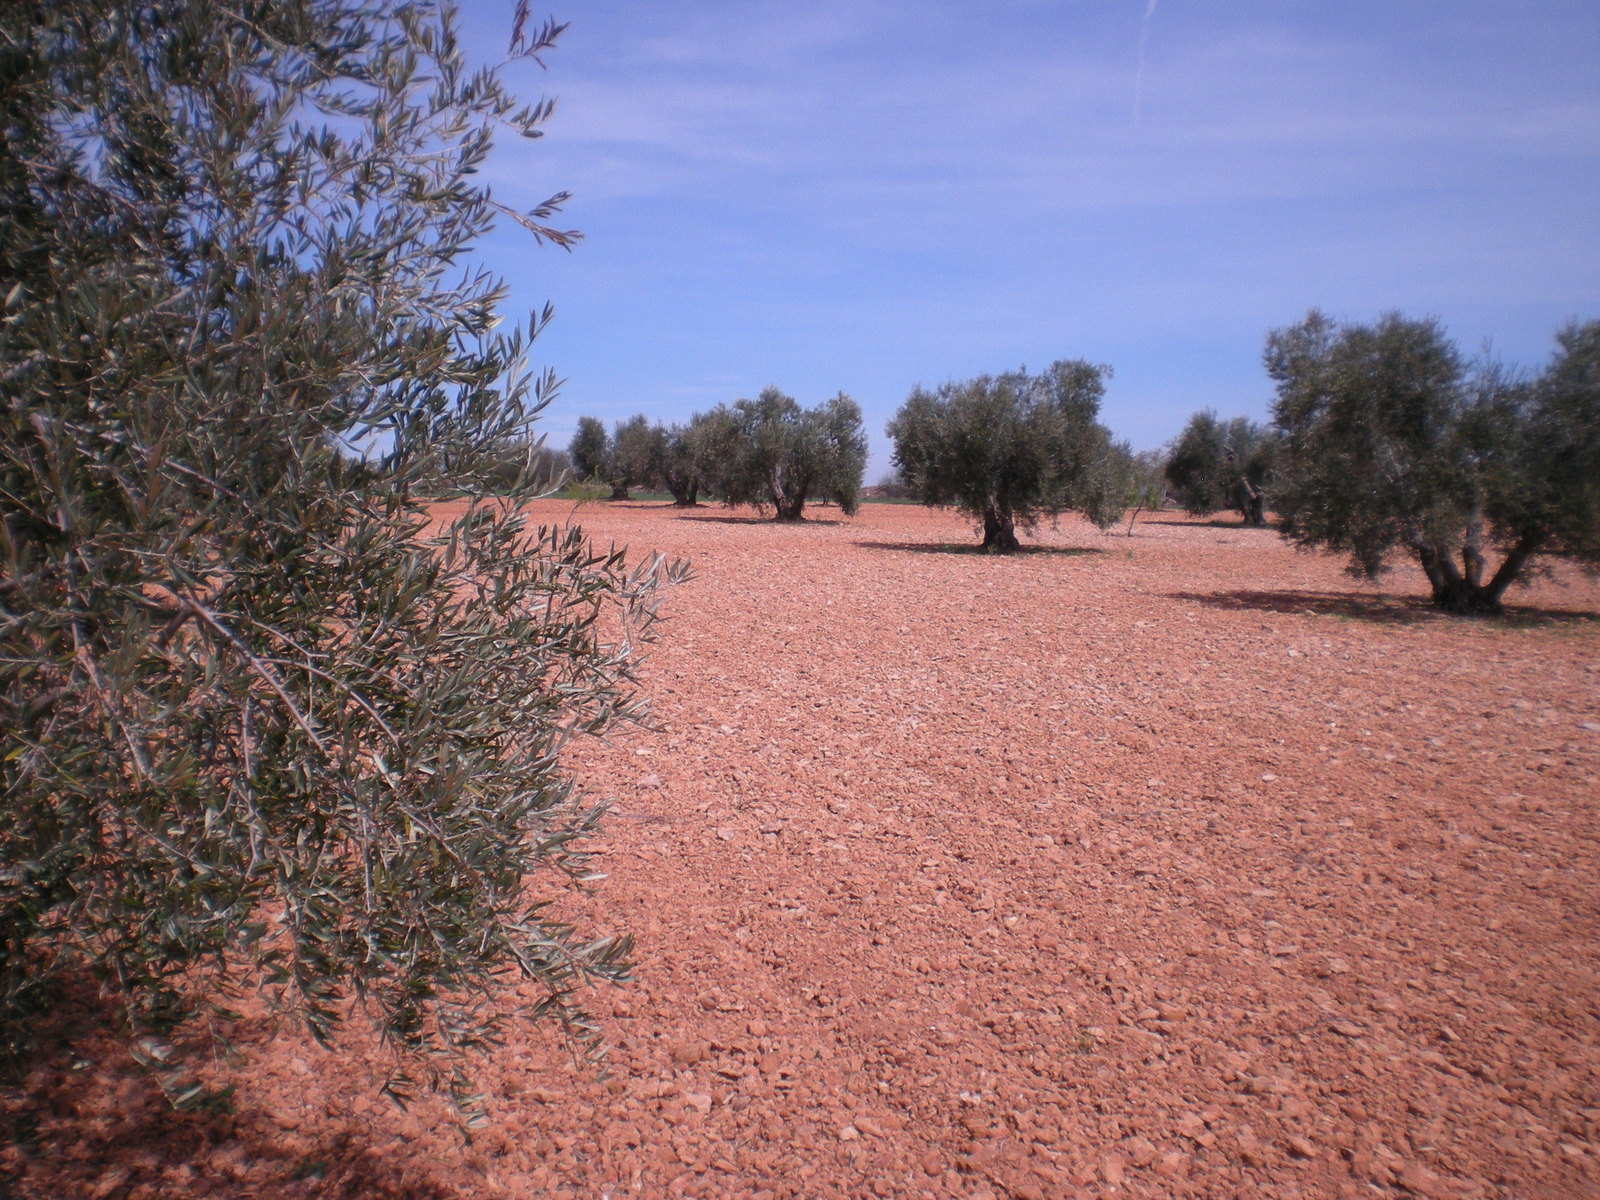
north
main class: Cropland
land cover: Olive groves
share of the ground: 10 - 25 %
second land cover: Other bare soil
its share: > 75 %
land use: Agriculture (excluding fallow land and kitchen gardens)
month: March
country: ES
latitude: 39.0181
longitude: -3.2374
